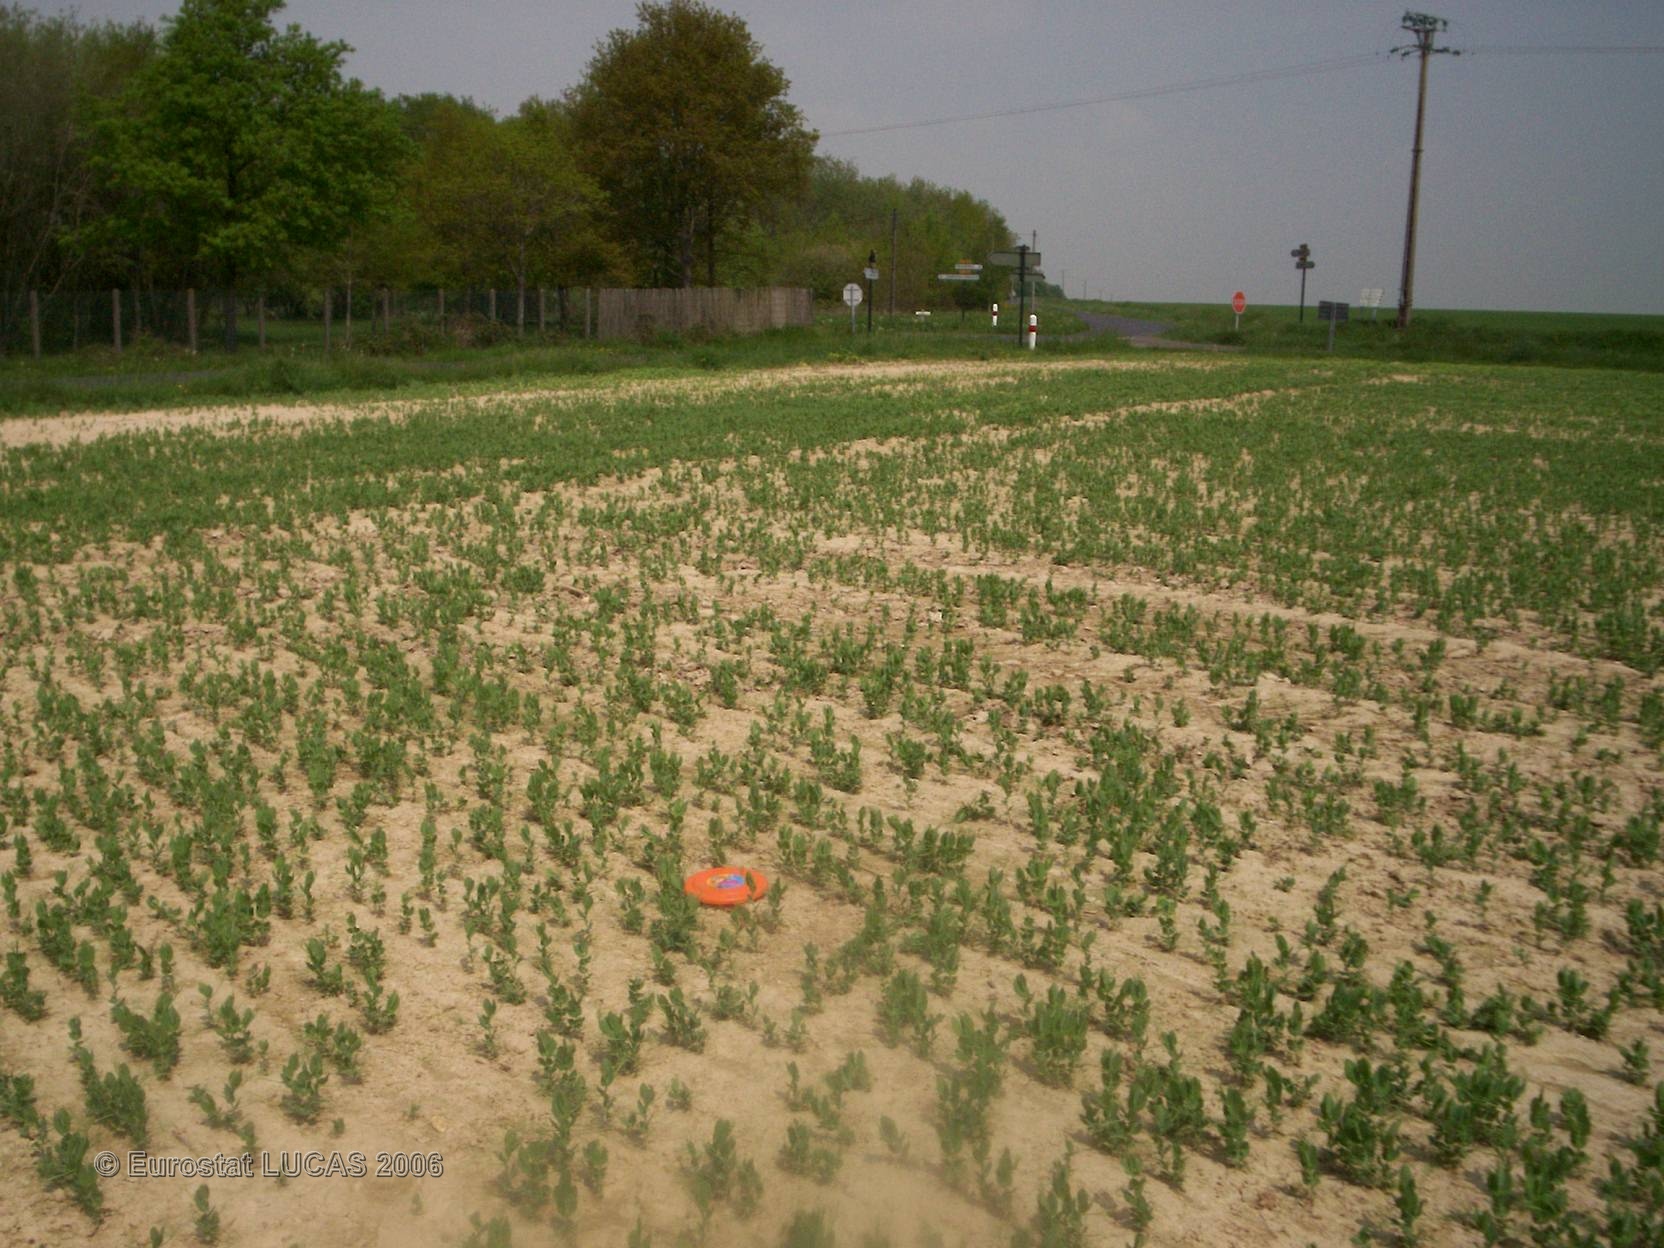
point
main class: Cropland
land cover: Dry pulses
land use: Agriculture (excluding fallow land and kitchen gardens)
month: May
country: FR
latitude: 47.9086
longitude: 2.9690
